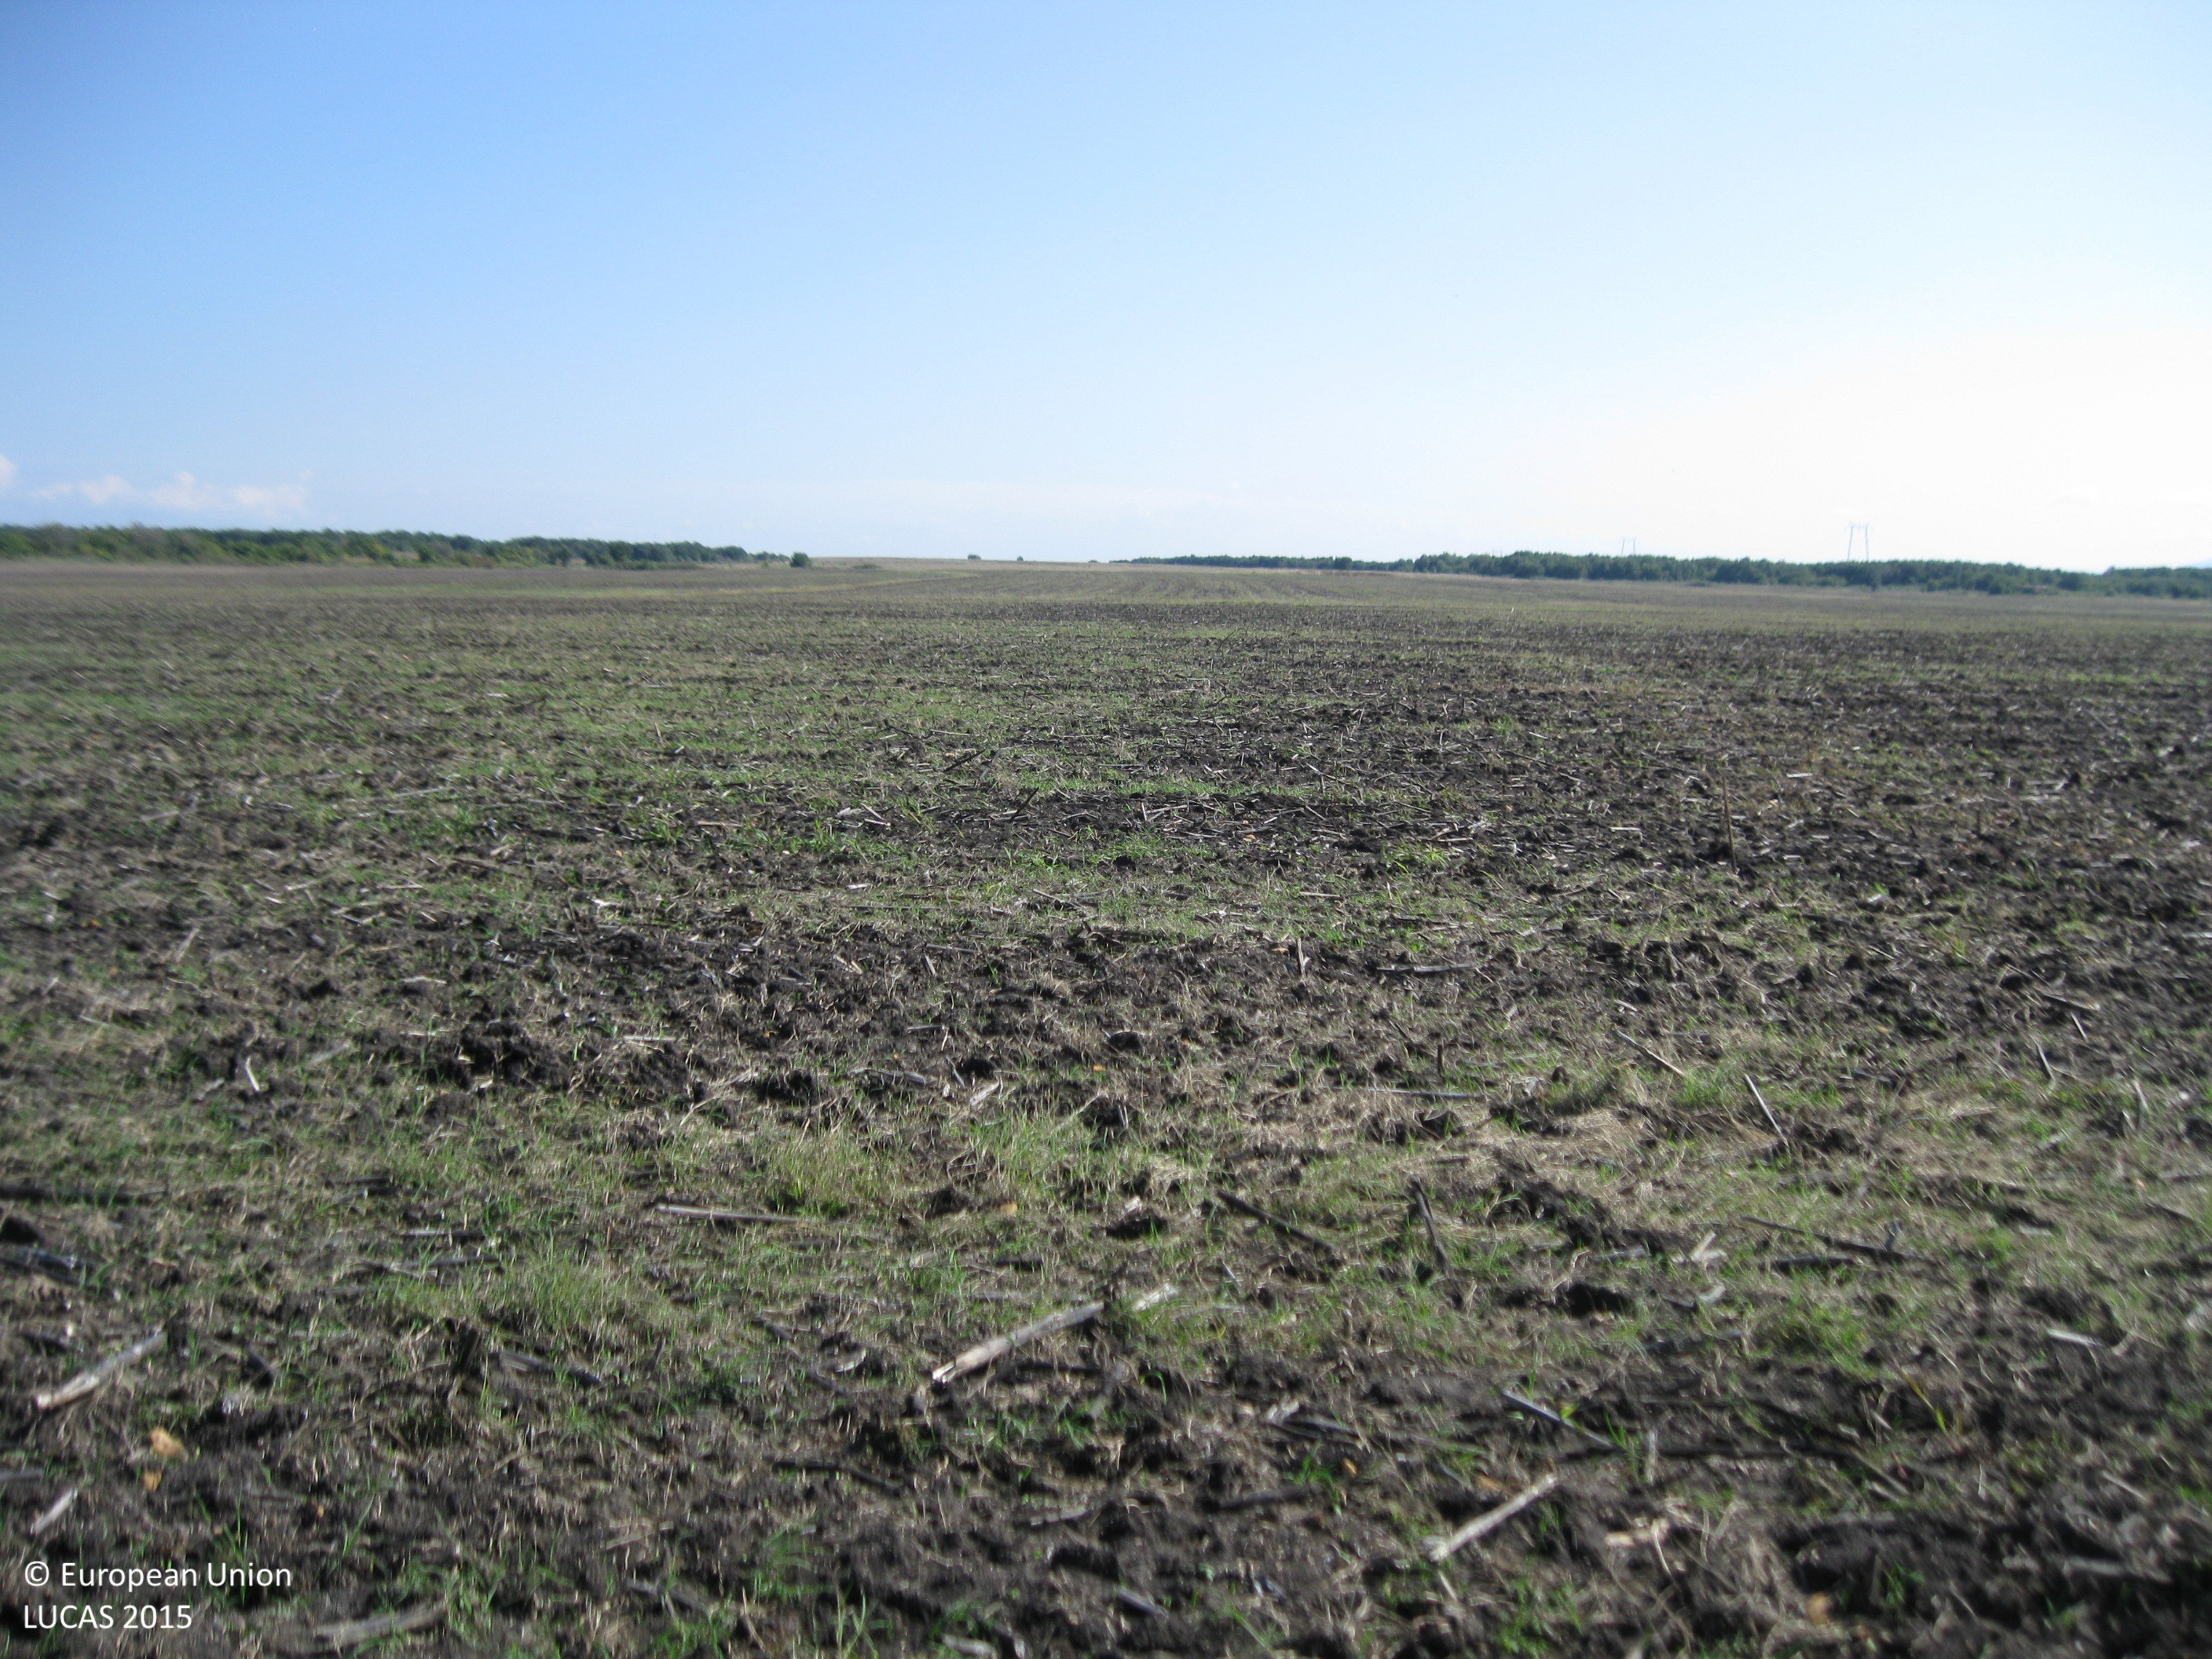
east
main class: Cropland
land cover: Sunflower
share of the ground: 10 - 25 %
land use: Agriculture (excluding fallow land and kitchen gardens)
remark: Harvested field
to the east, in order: Sunflower; Tracks; Sunflower; Tracks
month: October
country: BG
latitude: 42.1035
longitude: 24.9648
